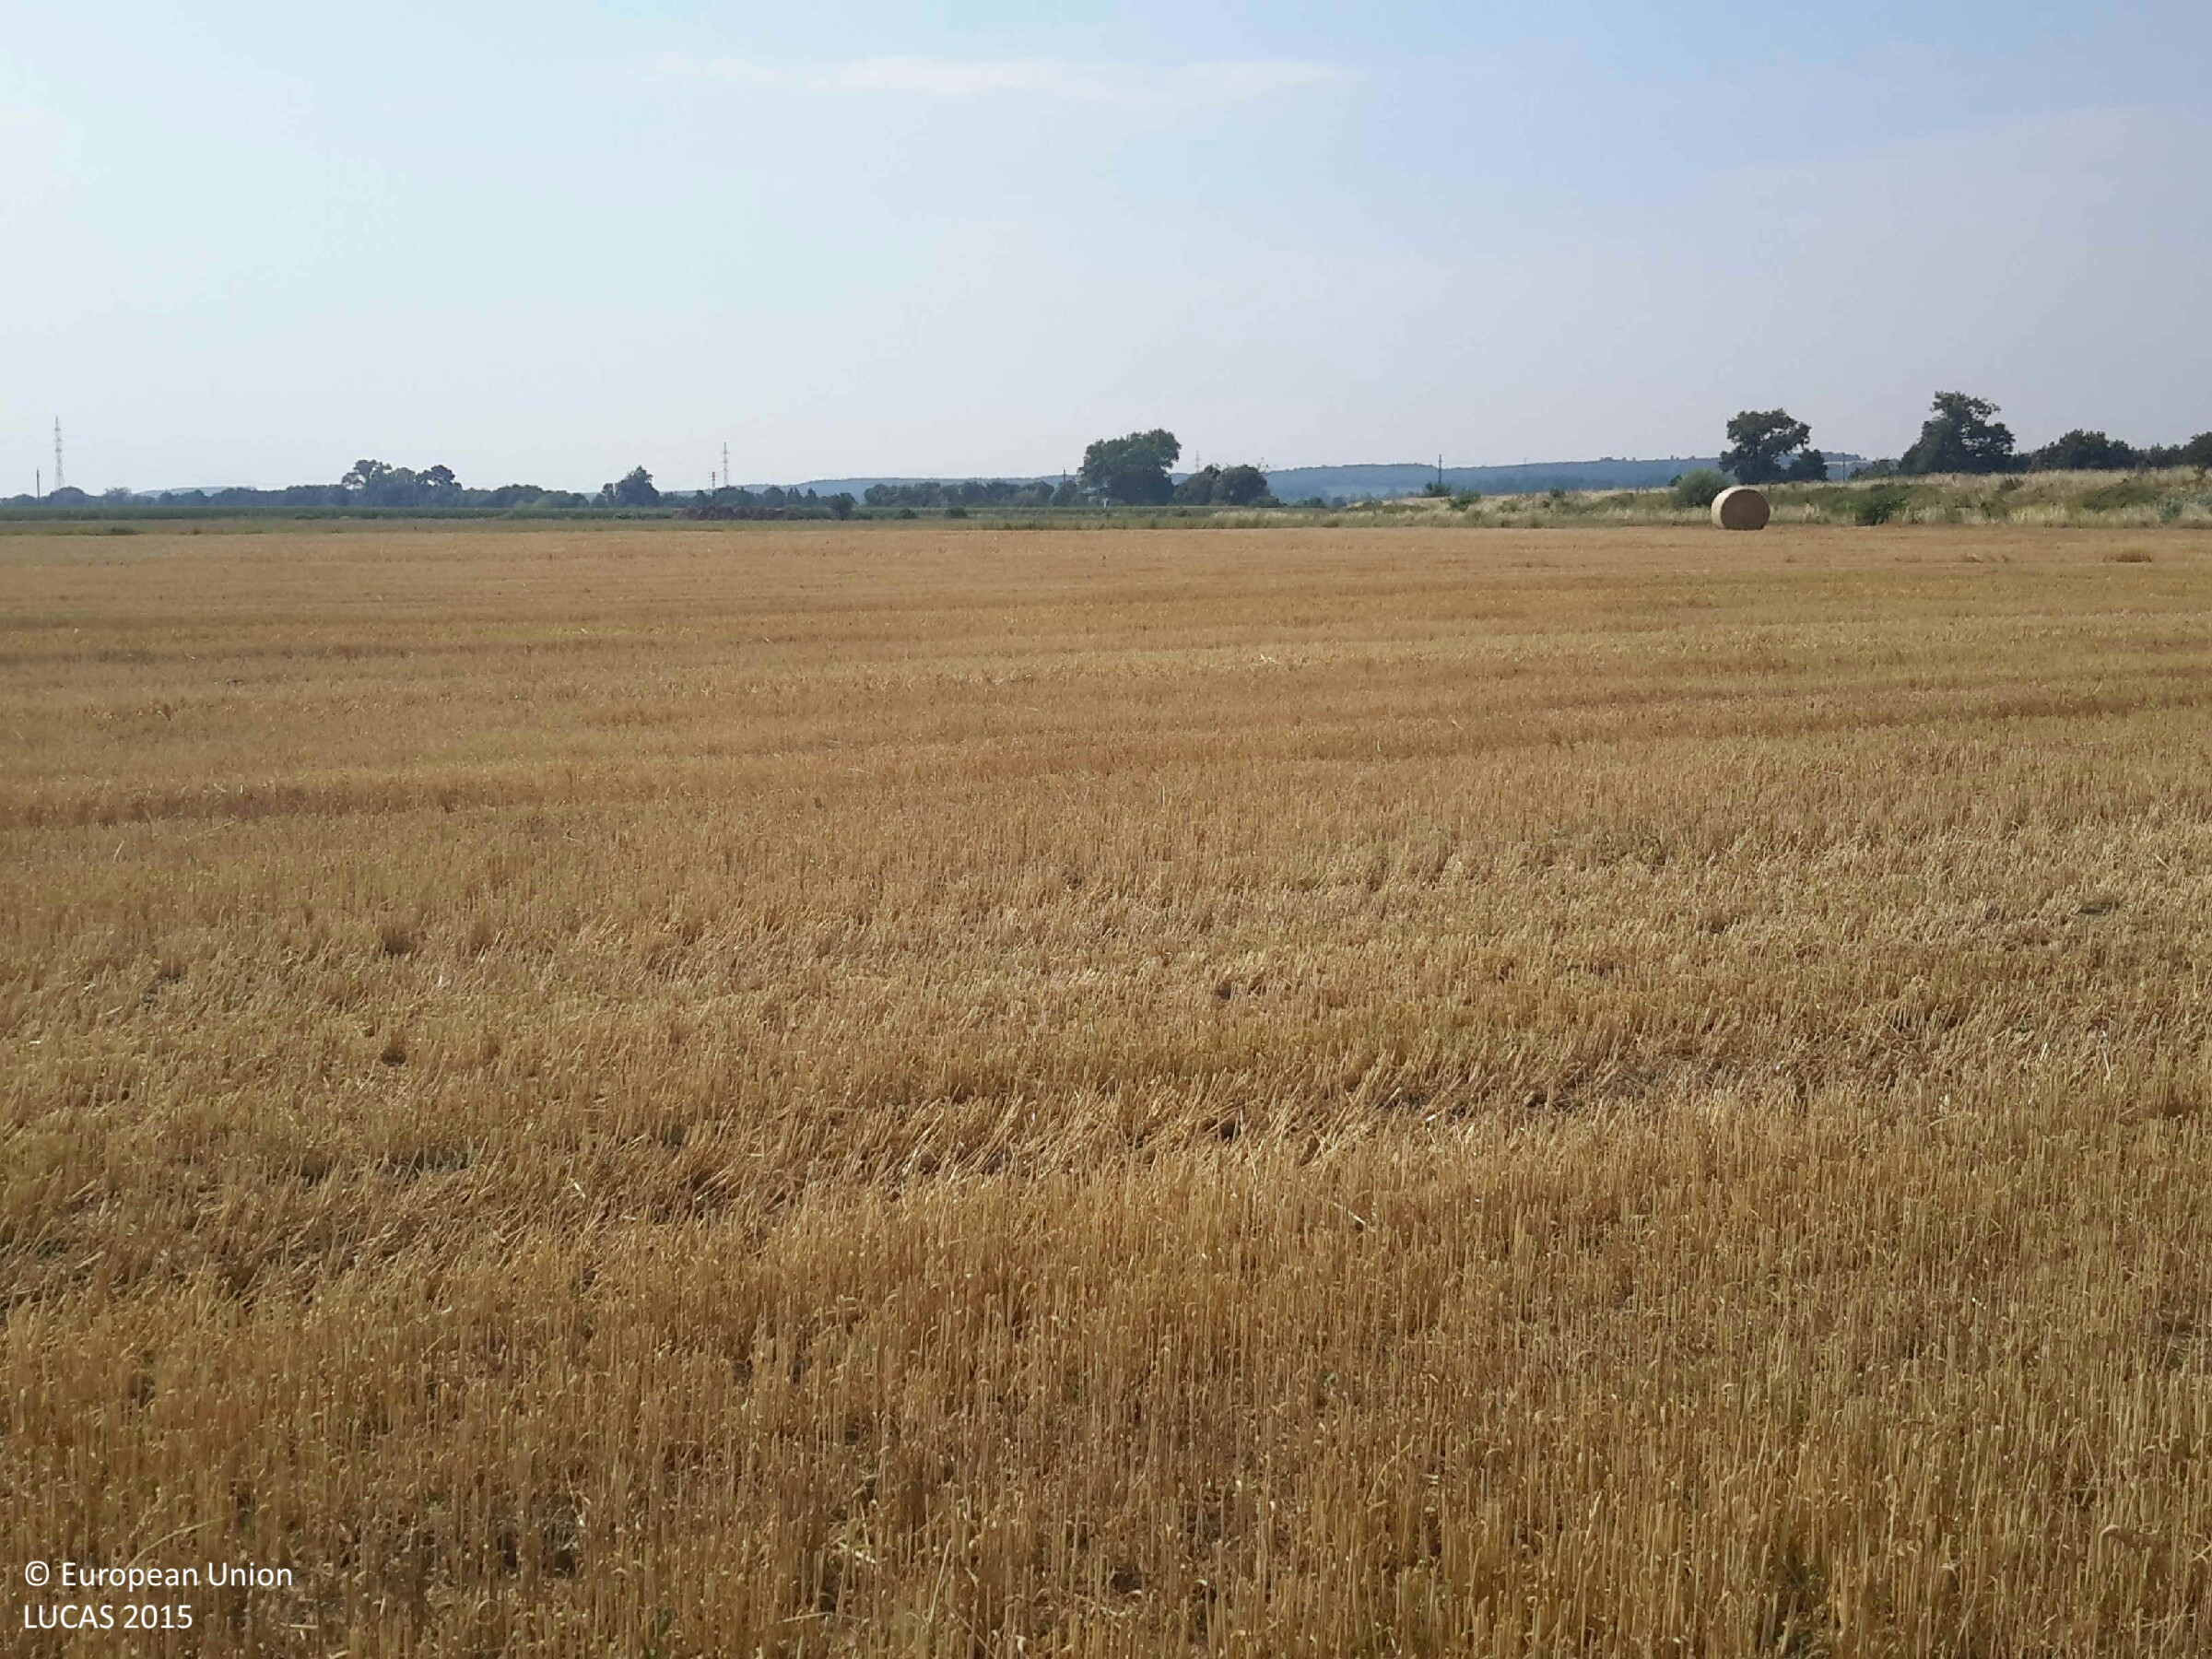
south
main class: Cropland
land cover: Common wheat
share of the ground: 50 - 75 %
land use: Agriculture (excluding fallow land and kitchen gardens)
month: July
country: HU
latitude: 47.4043
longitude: 16.7227
